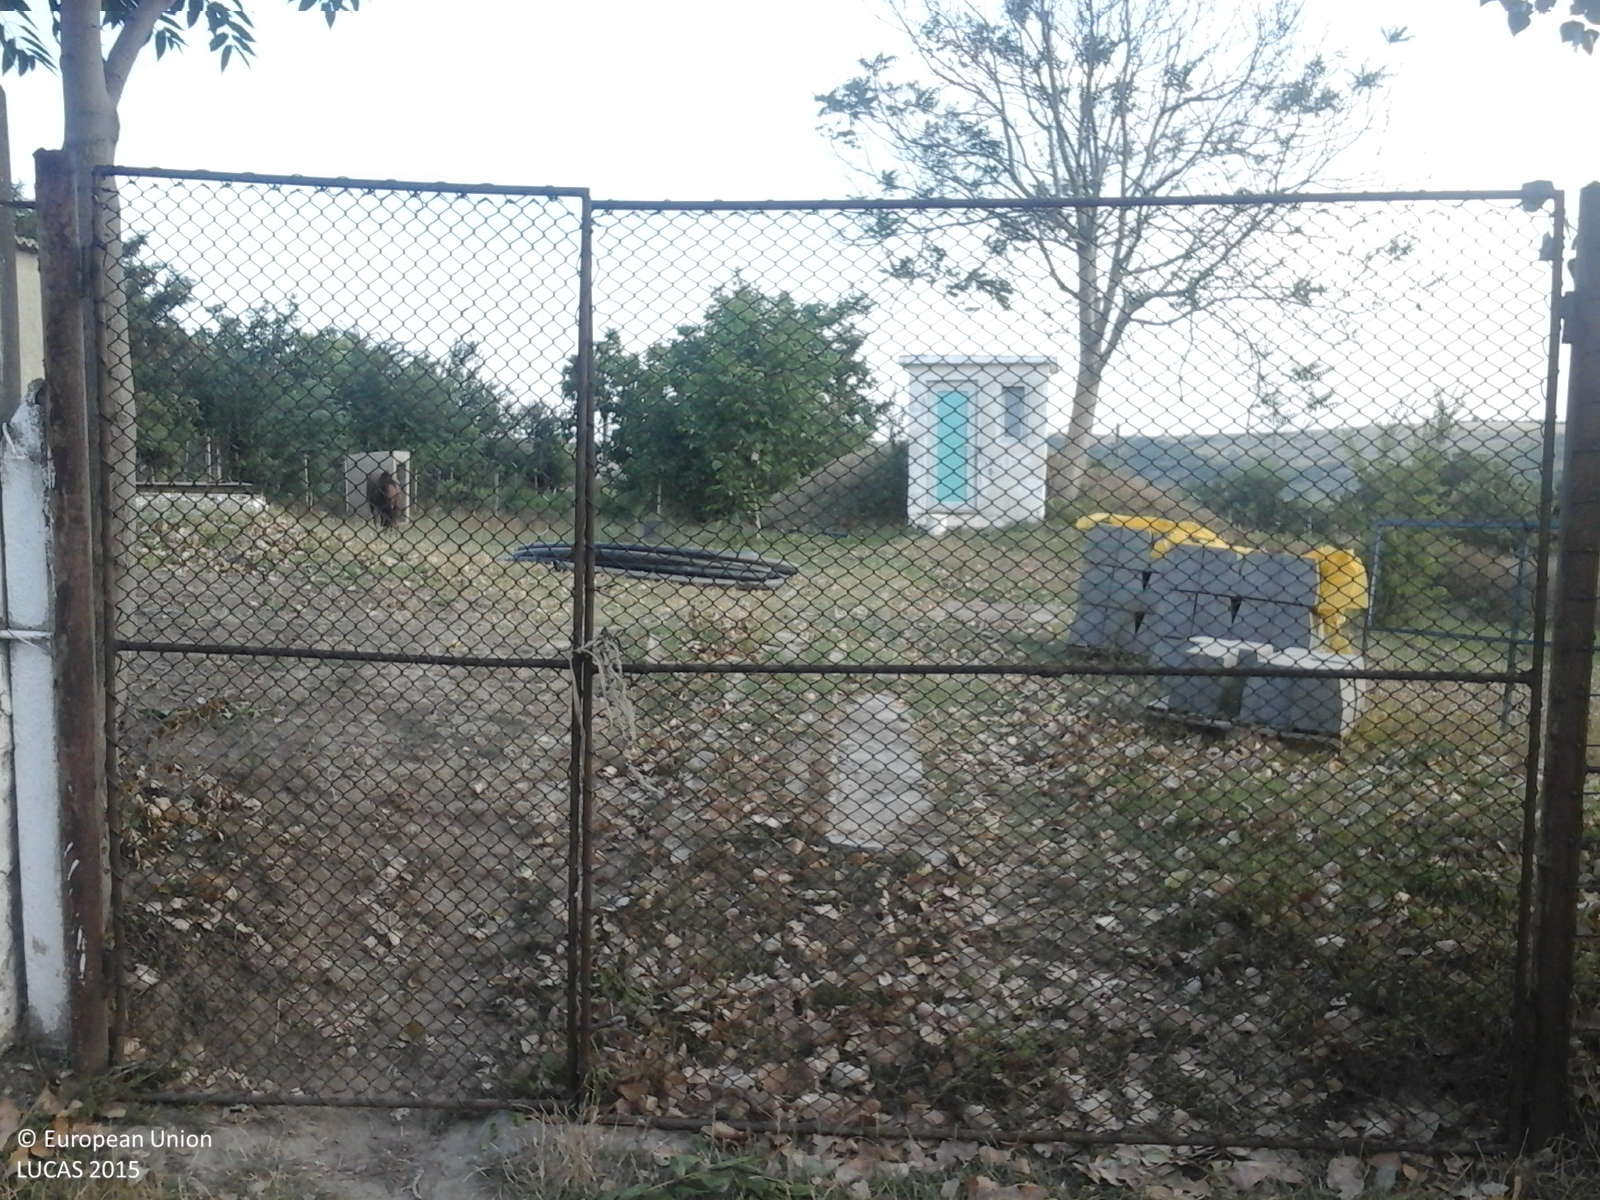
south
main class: Grassland
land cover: Grassland with sparse tree/shrub cover
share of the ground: > 75 %
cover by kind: herbaceous plants 85 %, shrubs 10 %, broadleaved forest trees 5 %
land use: Community services
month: August
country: RO
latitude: 44.3719
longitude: 28.0666
